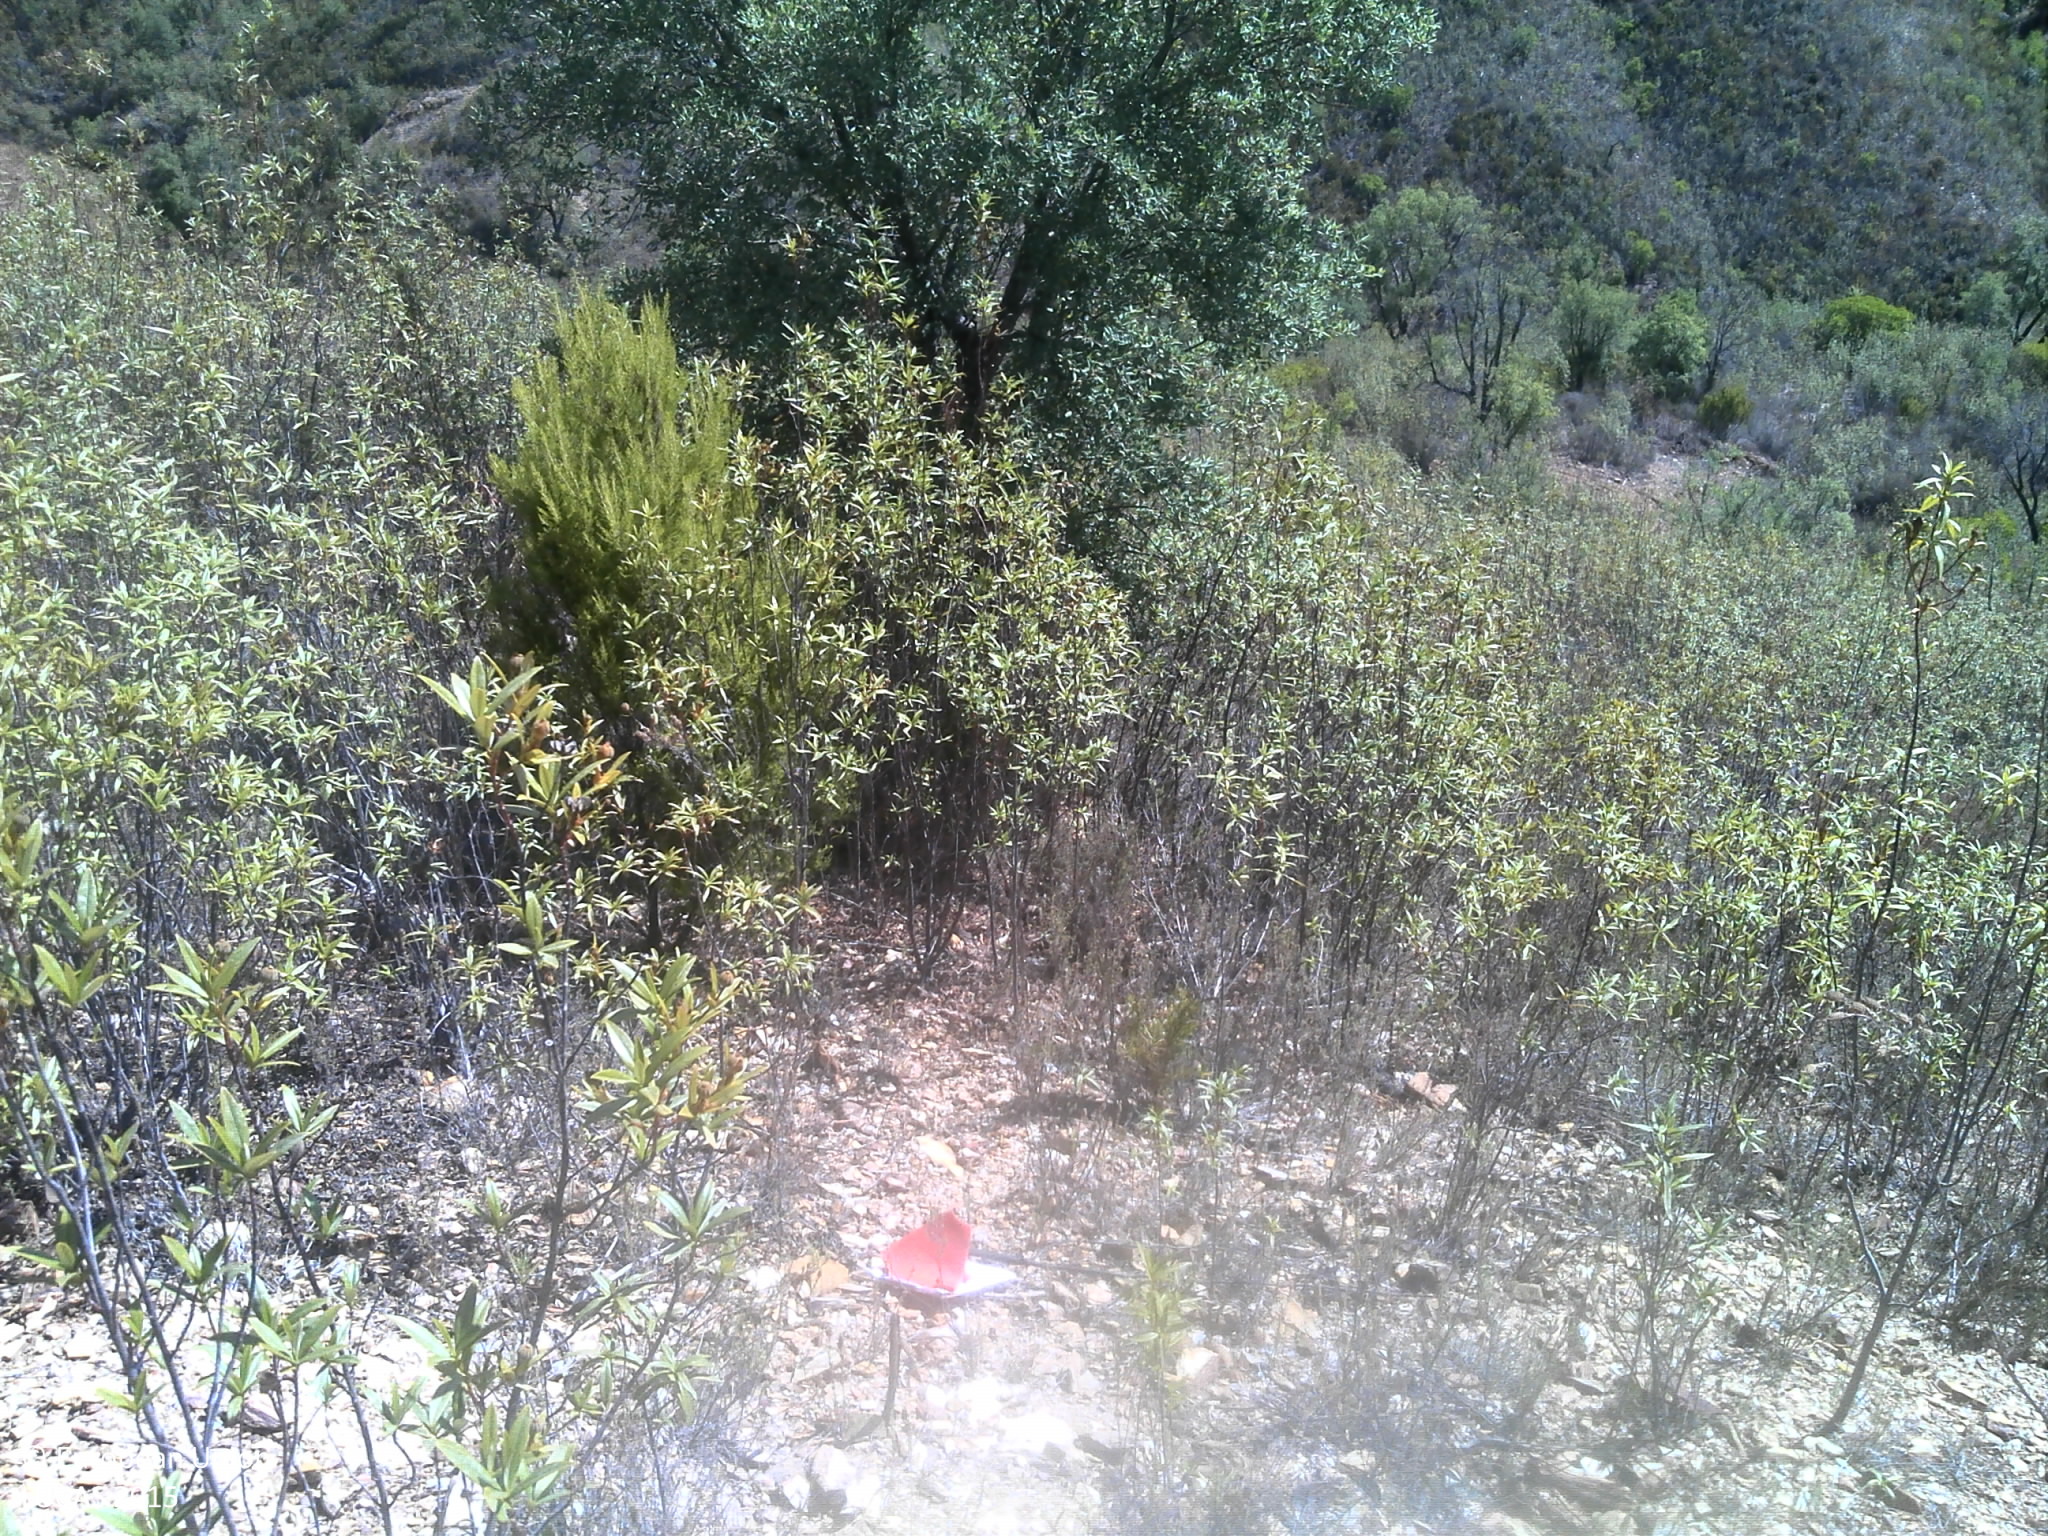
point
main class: Shrubland
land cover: Shrubland with sparse tree cover
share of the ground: 25 - 50 %
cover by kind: shrubs 50 %, unconsolidated bare surface 35 %, herbaceous plants 10 %, broadleaved forest trees 5 %
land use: Semi-natural and natural areas not in use
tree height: < 5 m
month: September
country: PT
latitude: 37.3269
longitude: -8.2025
